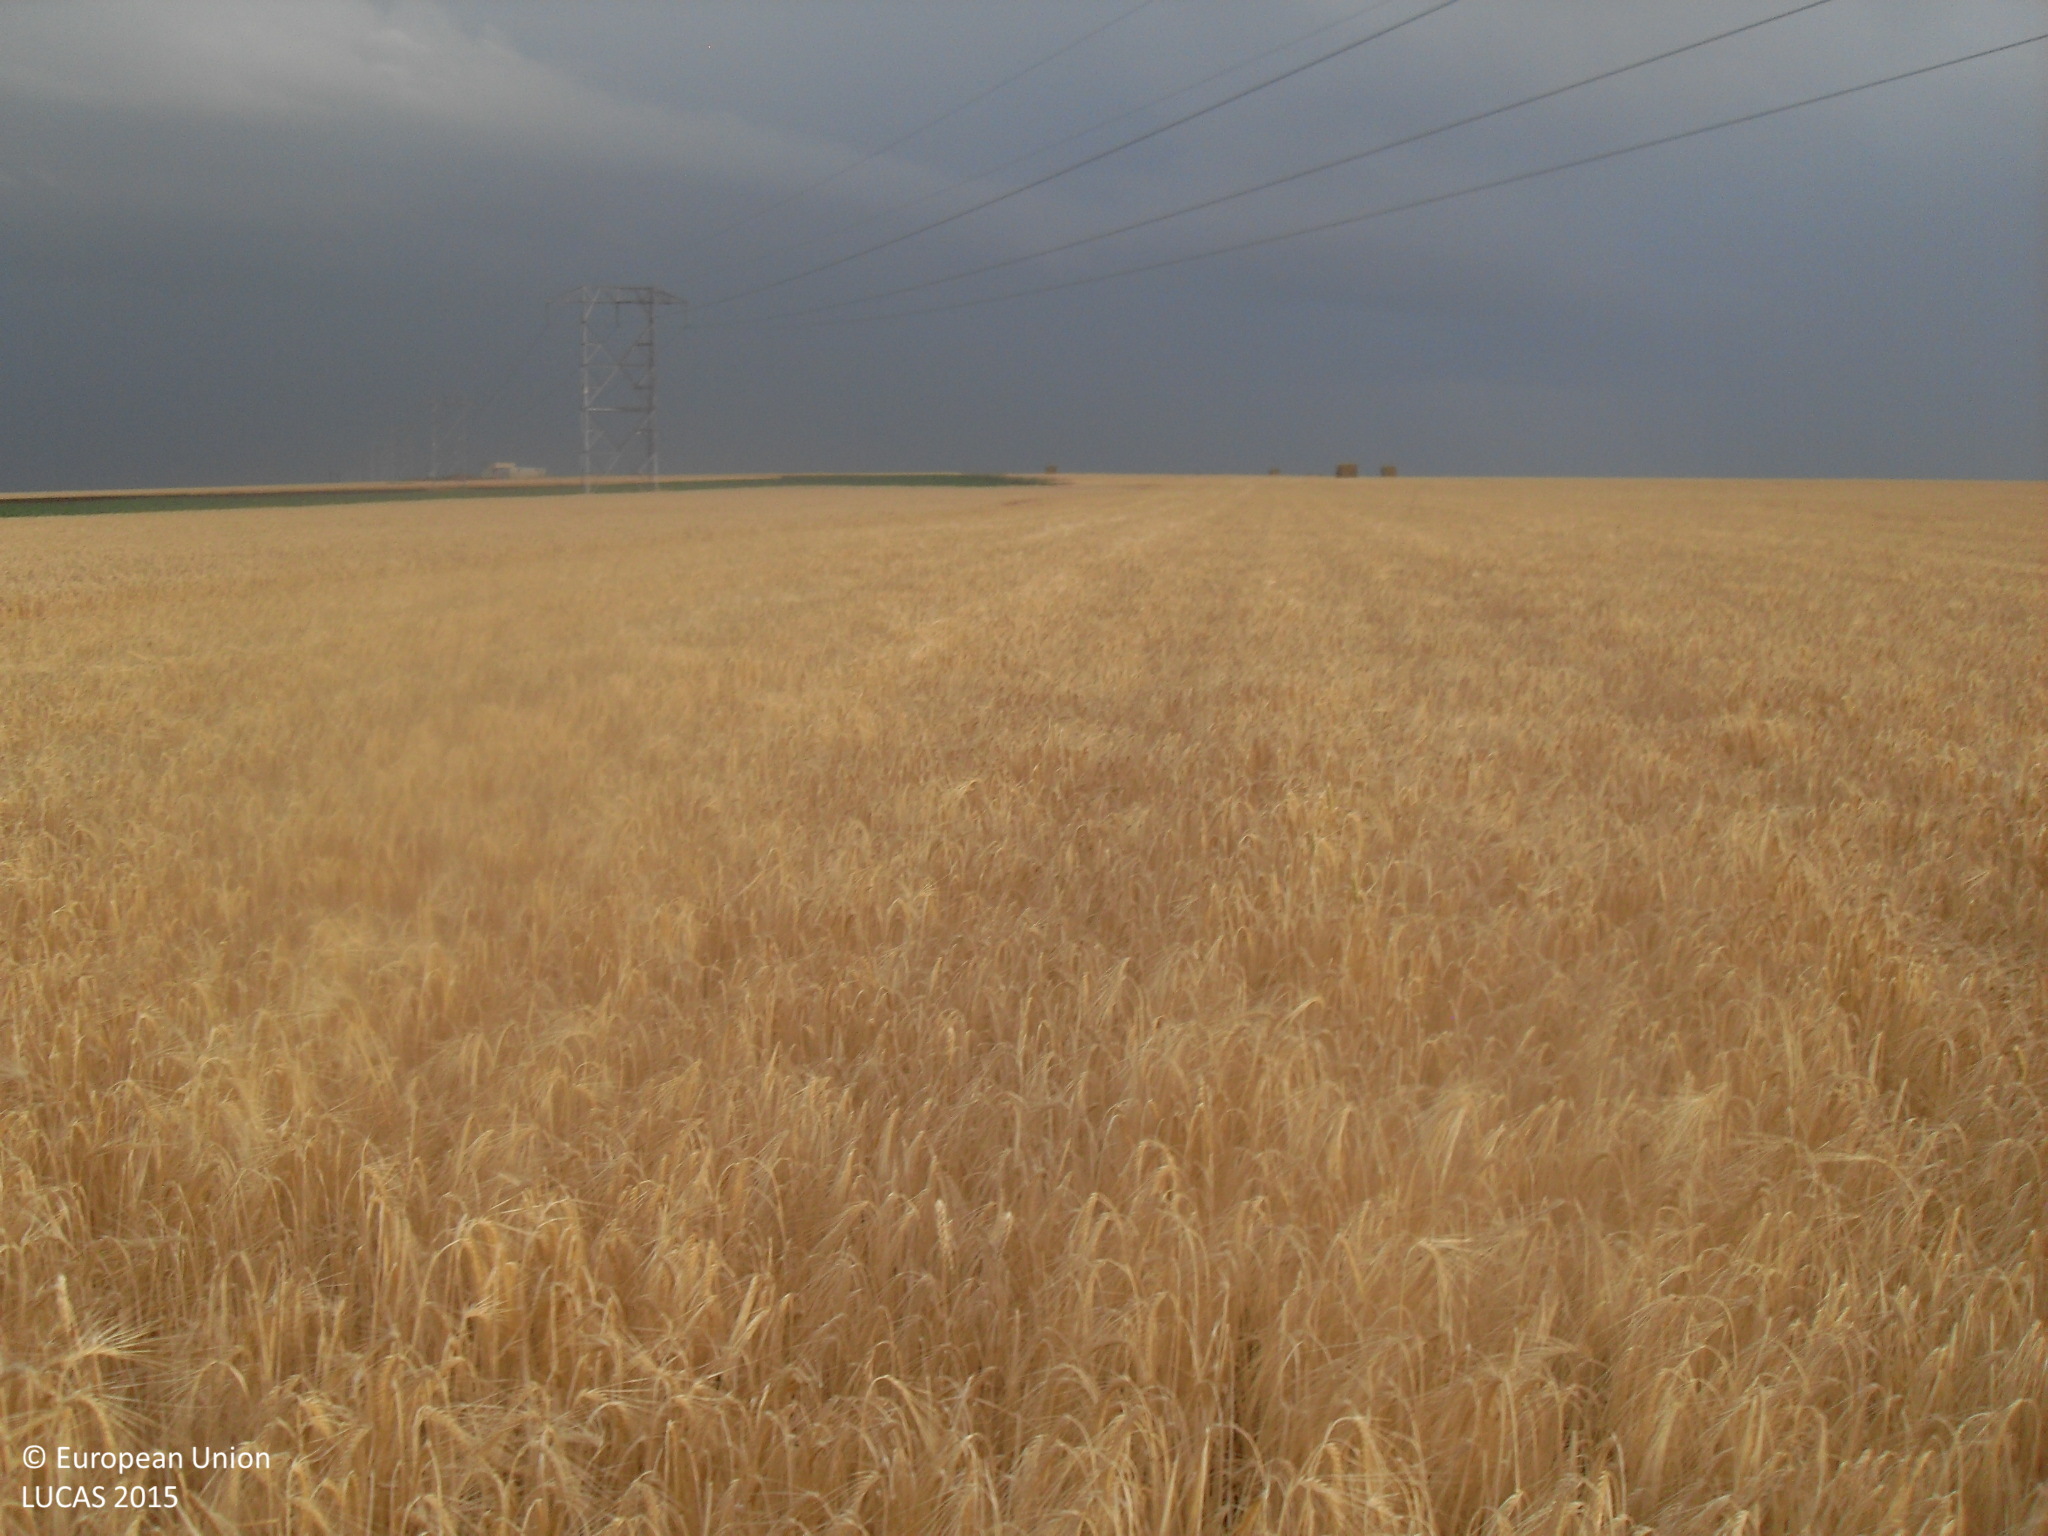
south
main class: Cropland
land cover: Barley
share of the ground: > 75 %
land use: Agriculture (excluding fallow land and kitchen gardens)
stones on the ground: 10 - 25 %
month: June
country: ES
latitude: 41.0708
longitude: -5.7059
